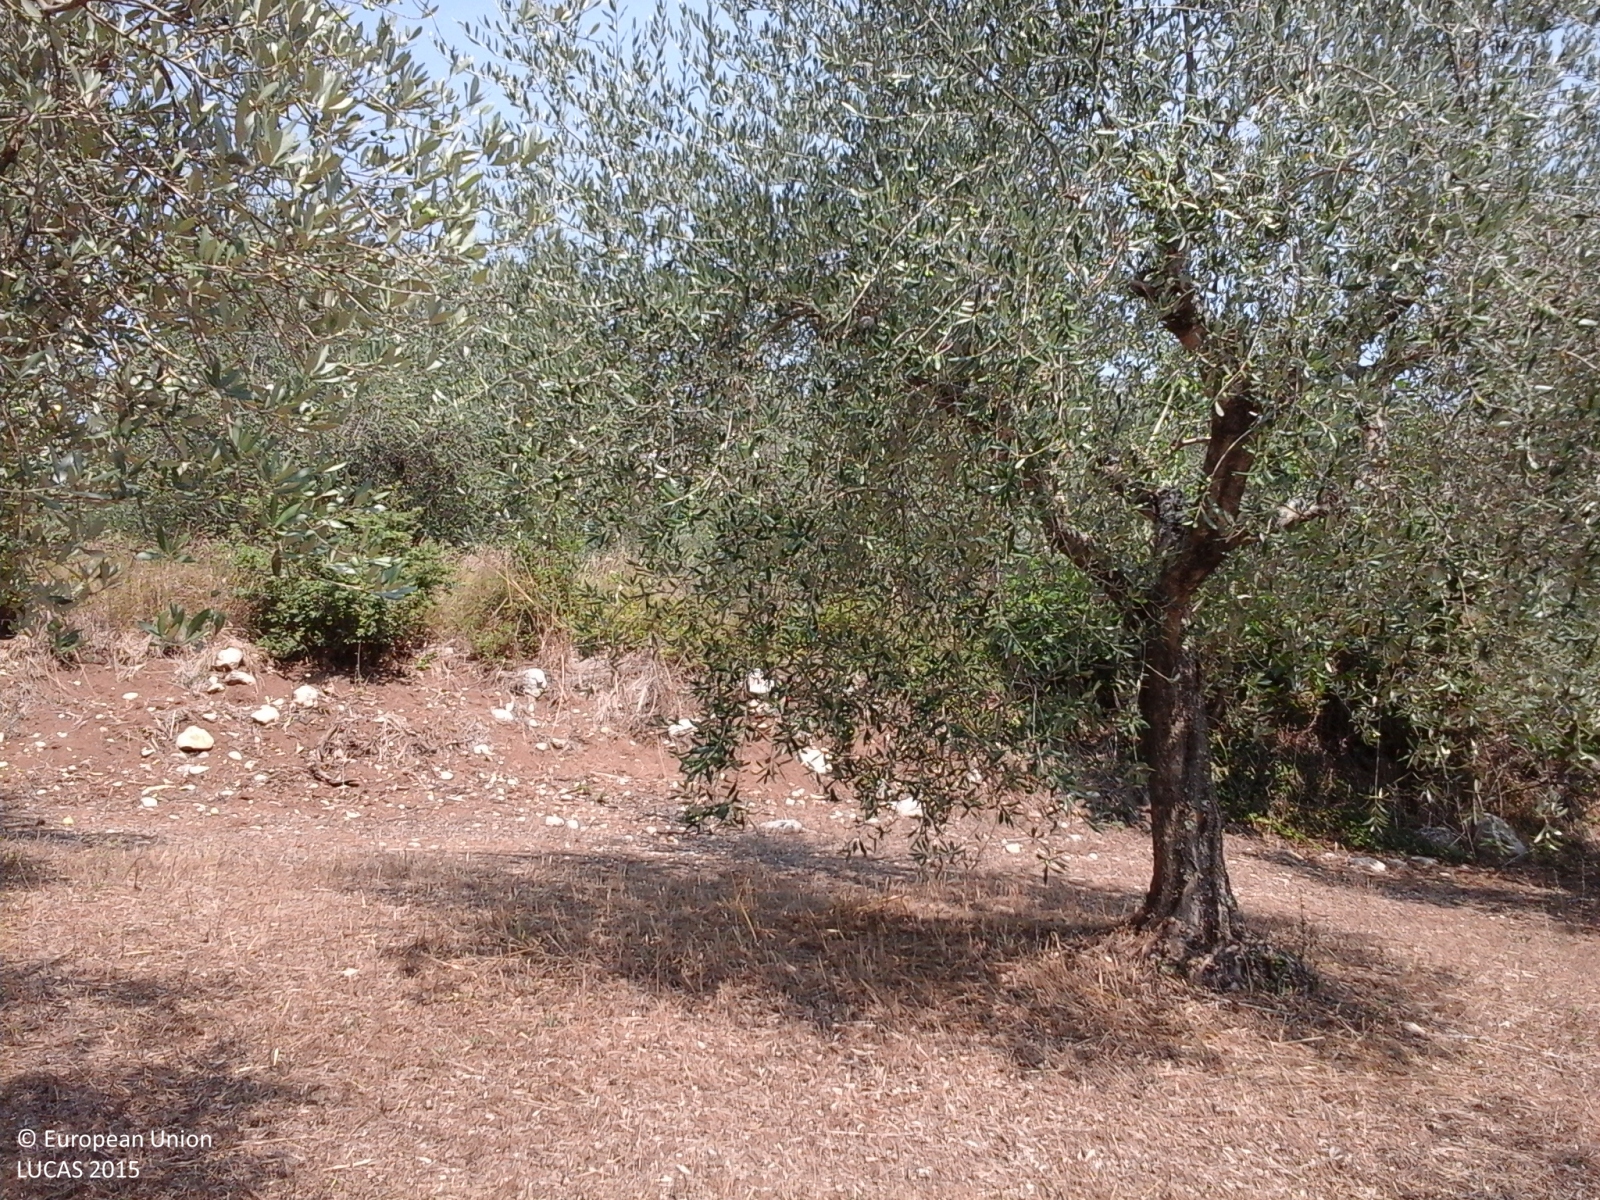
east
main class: Cropland
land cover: Olive groves
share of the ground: 50 - 75 %
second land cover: Spontaneously vegetated surfaces
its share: > 75 %
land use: Agriculture (excluding fallow land and kitchen gardens)
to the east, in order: Olive groves; Spontaneously vegetated surfaces; Olive groves; Grassland without tree/shrub cover; Olive groves; Broadleaved woodland
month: August
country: IT
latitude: 41.5190
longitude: 14.1668
